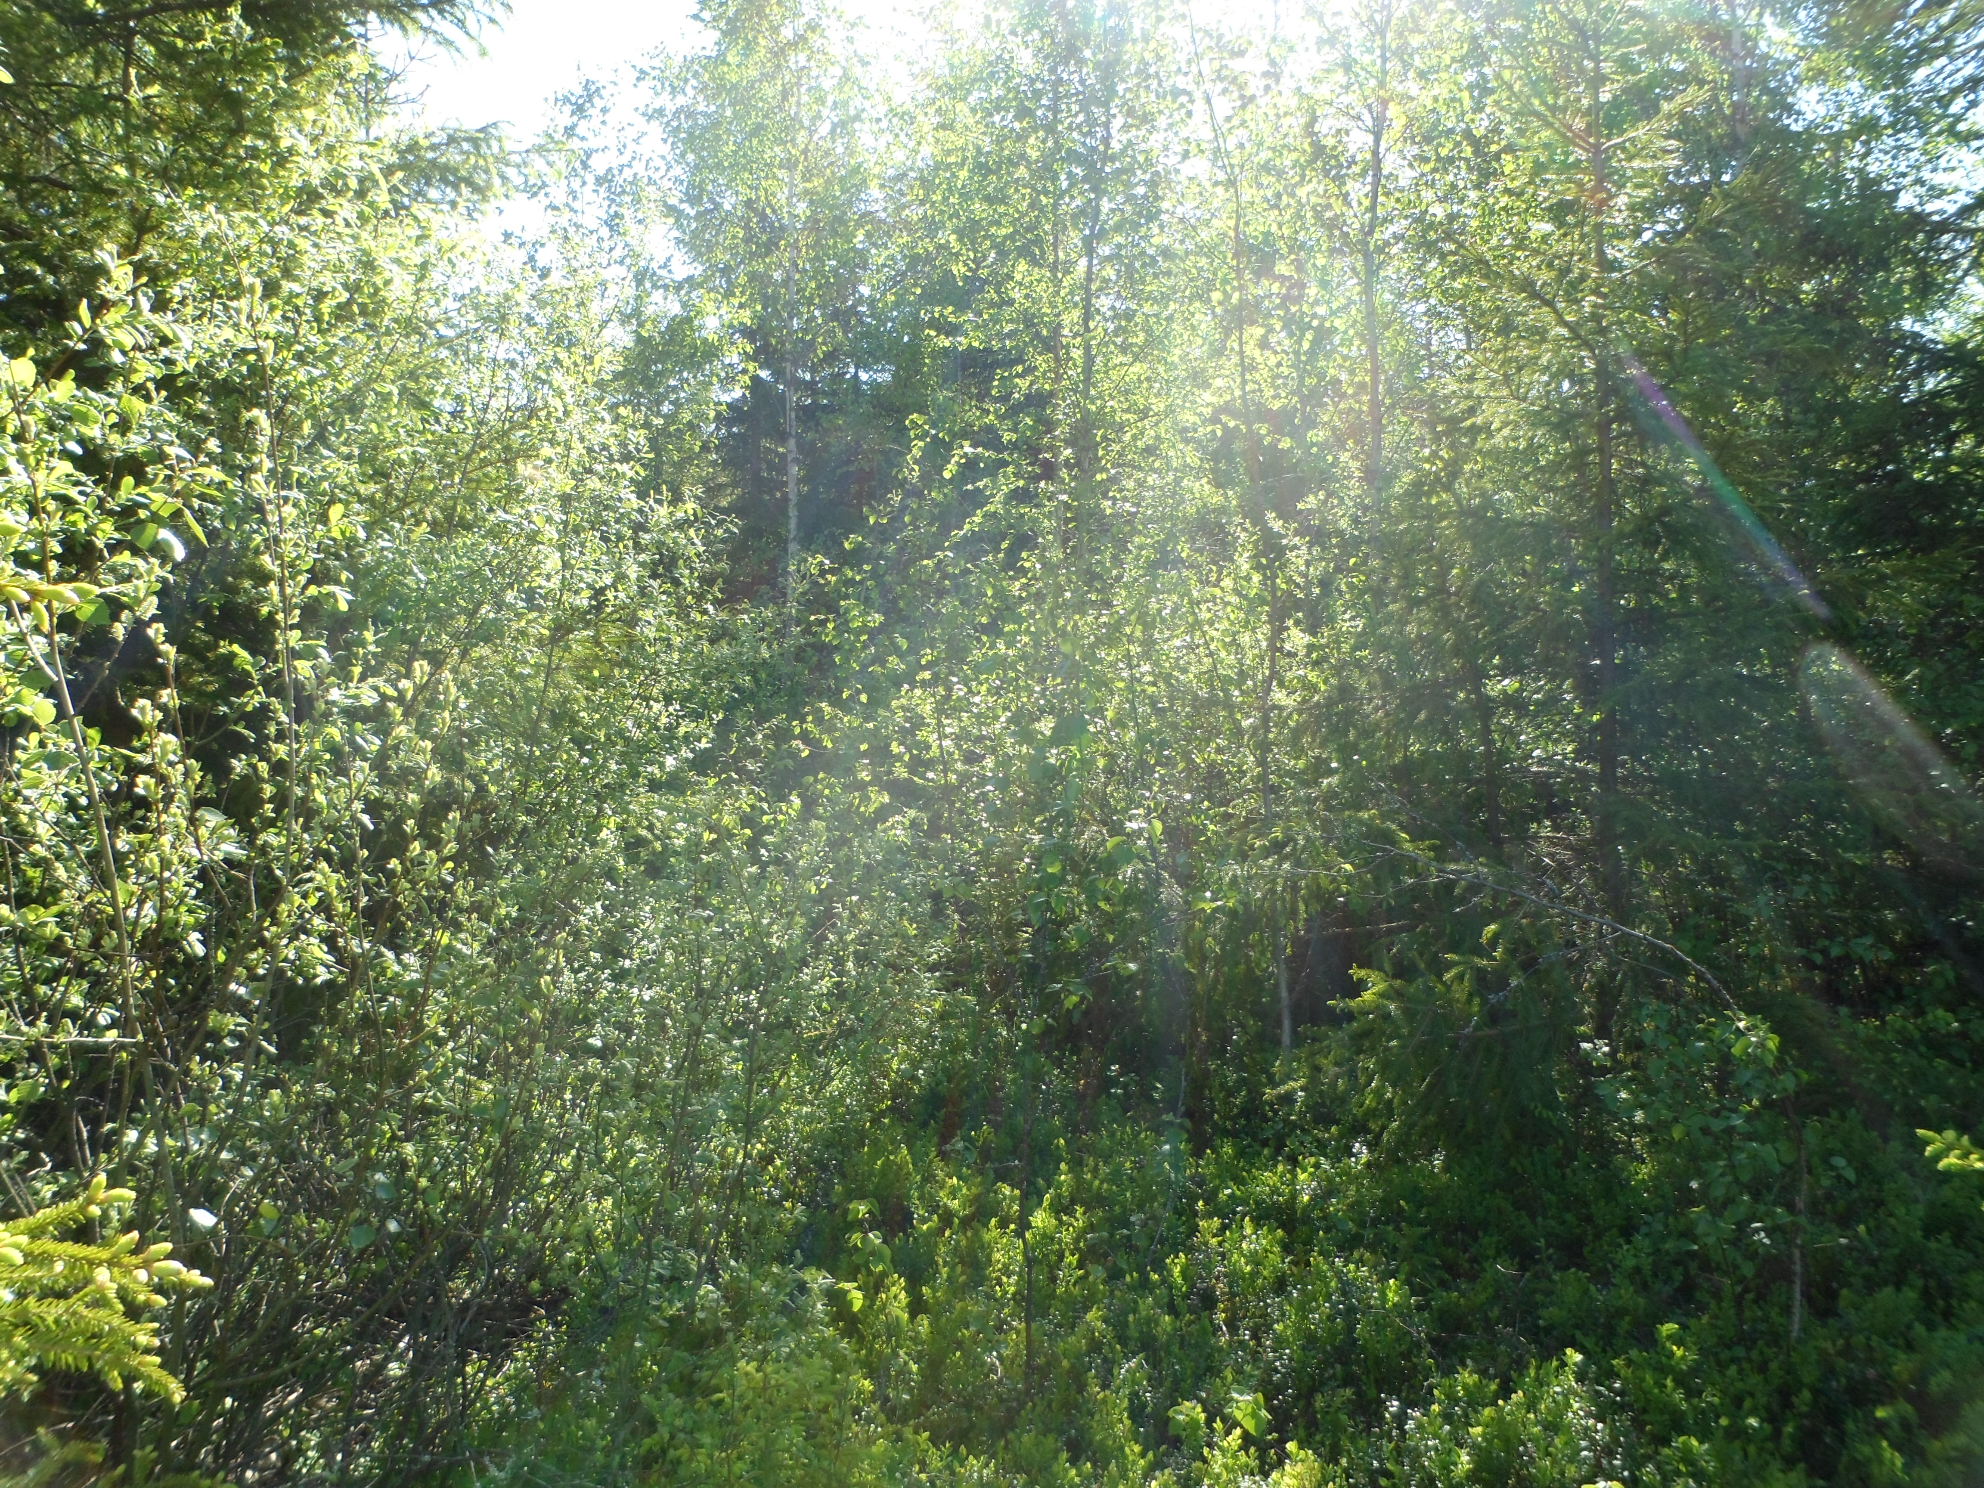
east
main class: Woodland
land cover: Spruce dominated mixed woodland
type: boreal forest
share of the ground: 50 - 75 %
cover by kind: coniferous forest trees 30 %, broadleaved forest trees 30 %, shrubs 25 %, lichens and mosses 10 %, herbaceous plants 5 %
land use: Forestry
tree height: > 5 m
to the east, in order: Spruce dominated mixed woodland; Broadleaved woodland; Ditches and canals; Spruce dominated mixed woodland; Dry stone walls; Artificial constructions in urban areas; Spruce dominated mixed woodland; Ditches and canals; Grass margins; Paved roads, cycling and walking lanes; Ditches and canals; Electric lines; Broadleaved woodland
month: June
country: SE
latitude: 56.8879
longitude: 14.8720
